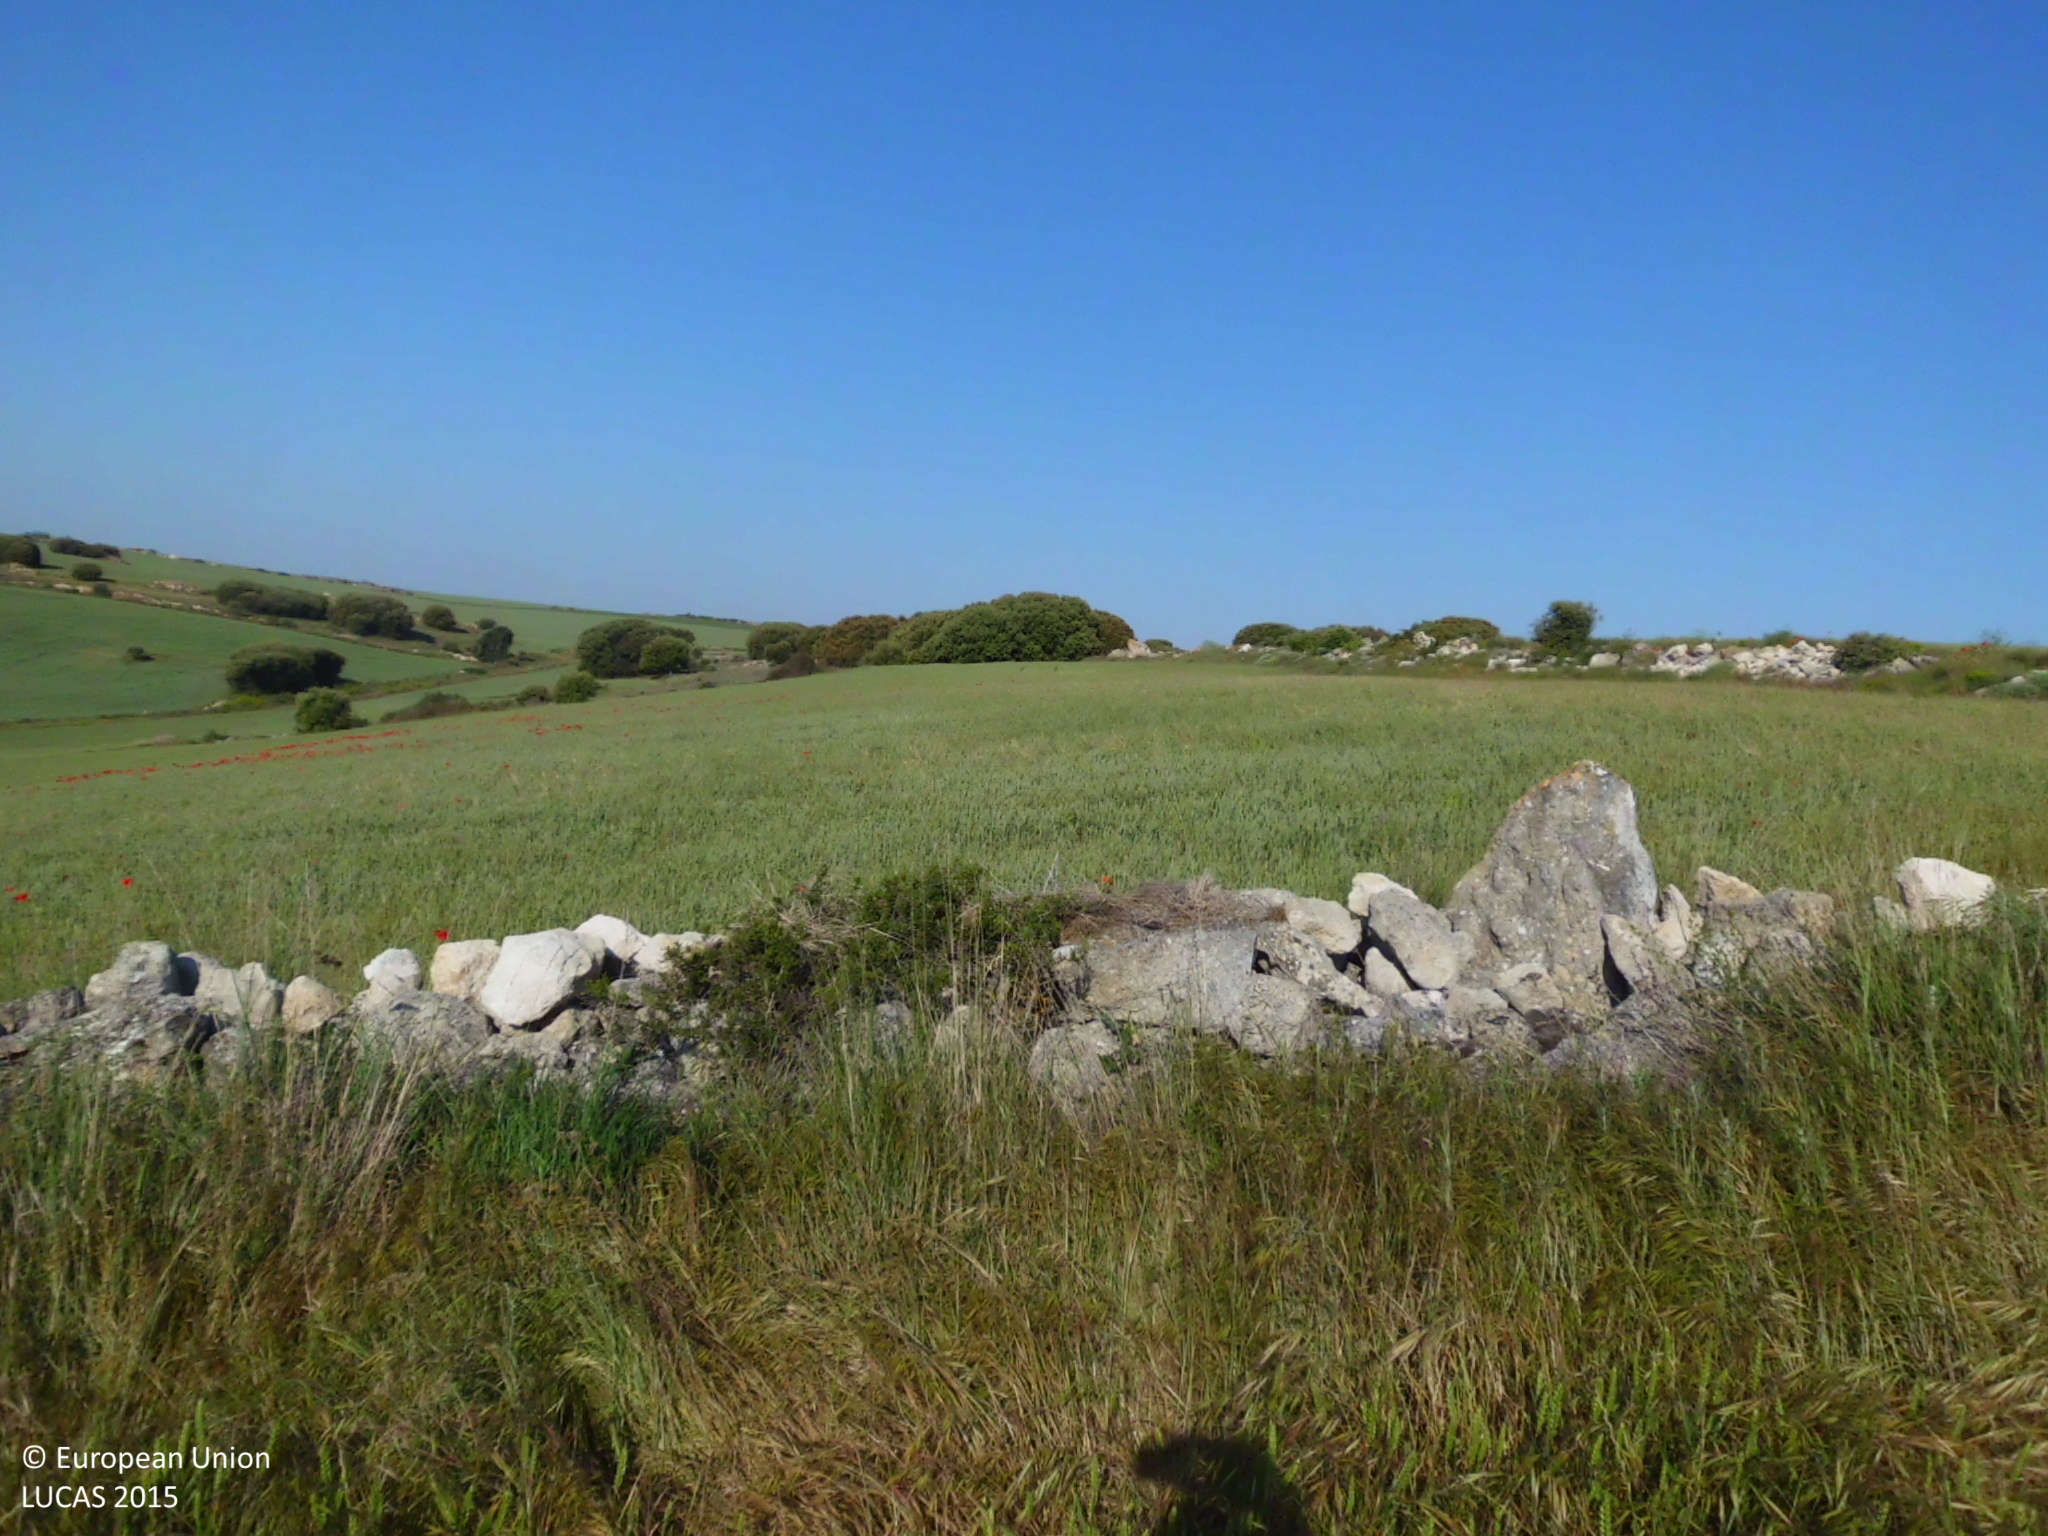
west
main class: Cropland
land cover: Common wheat
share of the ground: > 75 %
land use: Agriculture (excluding fallow land and kitchen gardens)
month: June
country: ES
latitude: 42.3404
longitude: -3.9622
